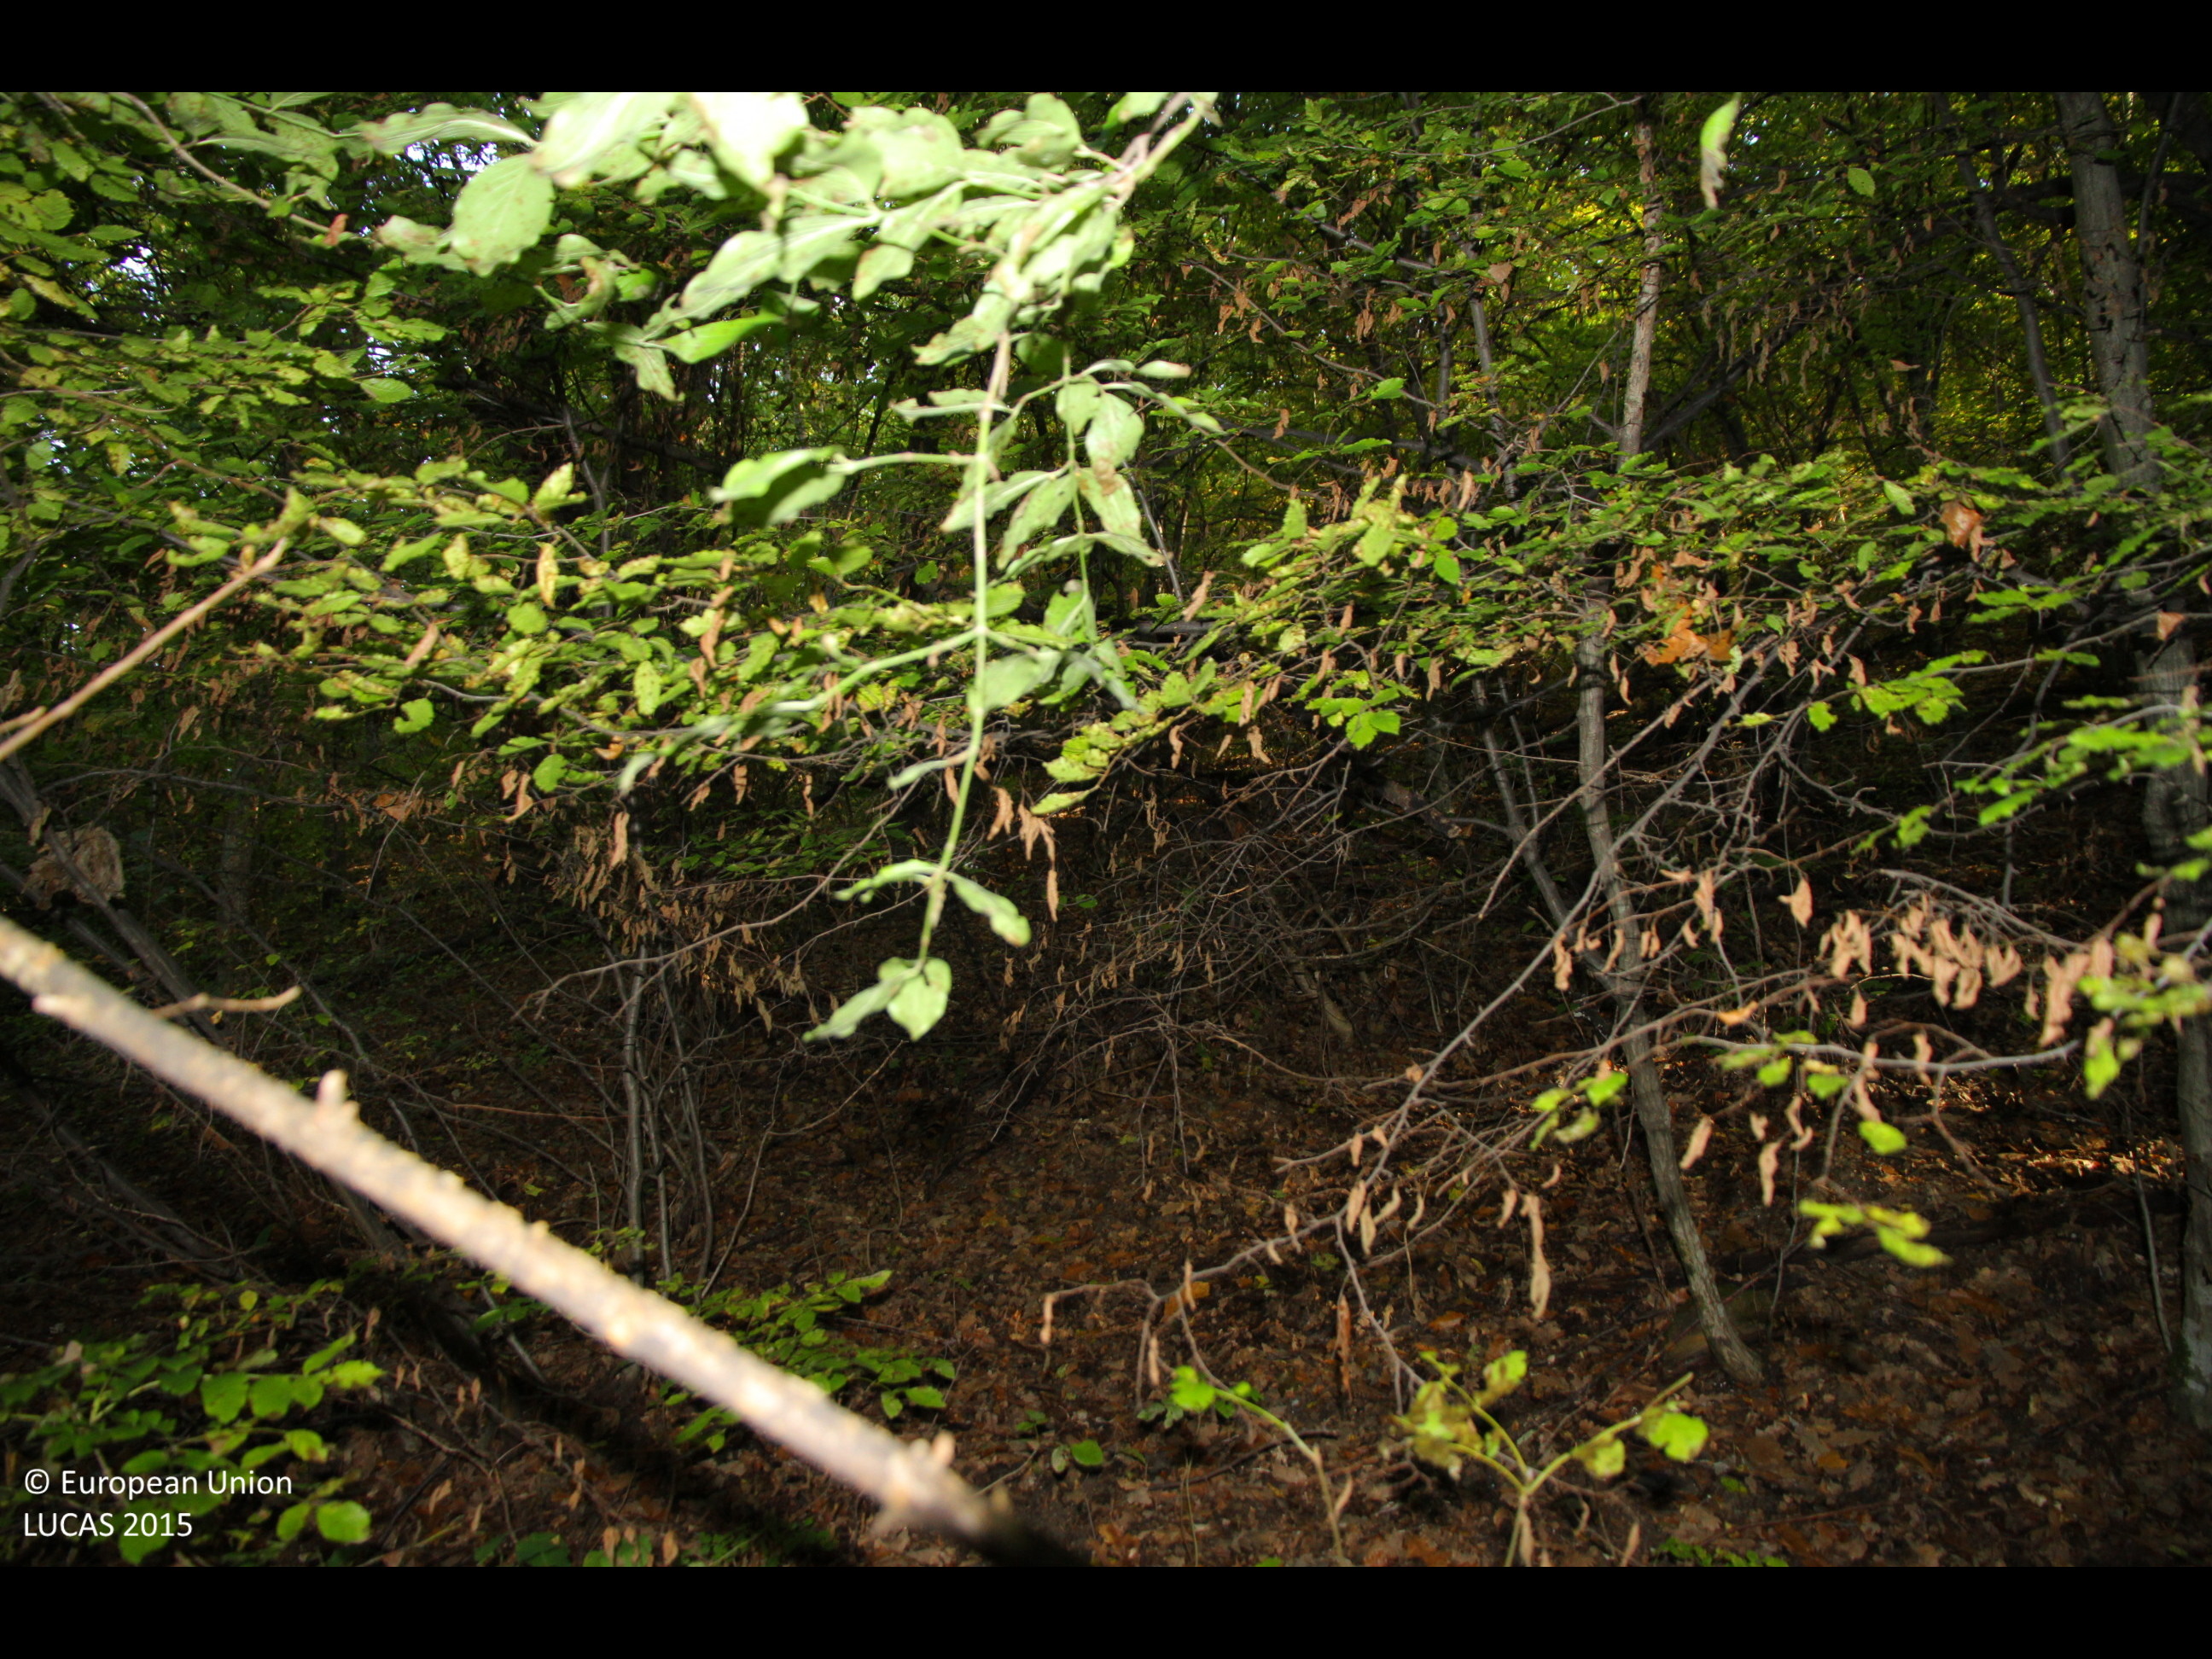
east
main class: Woodland
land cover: Broadleaved woodland
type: mesophytic deciduous forest
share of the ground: > 75 %
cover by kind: broadleaved forest trees 100 %
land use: Forestry
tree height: > 5 m
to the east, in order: Broadleaved woodland; Tracks; Broadleaved woodland
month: October
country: BG
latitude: 43.0337
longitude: 26.9620
